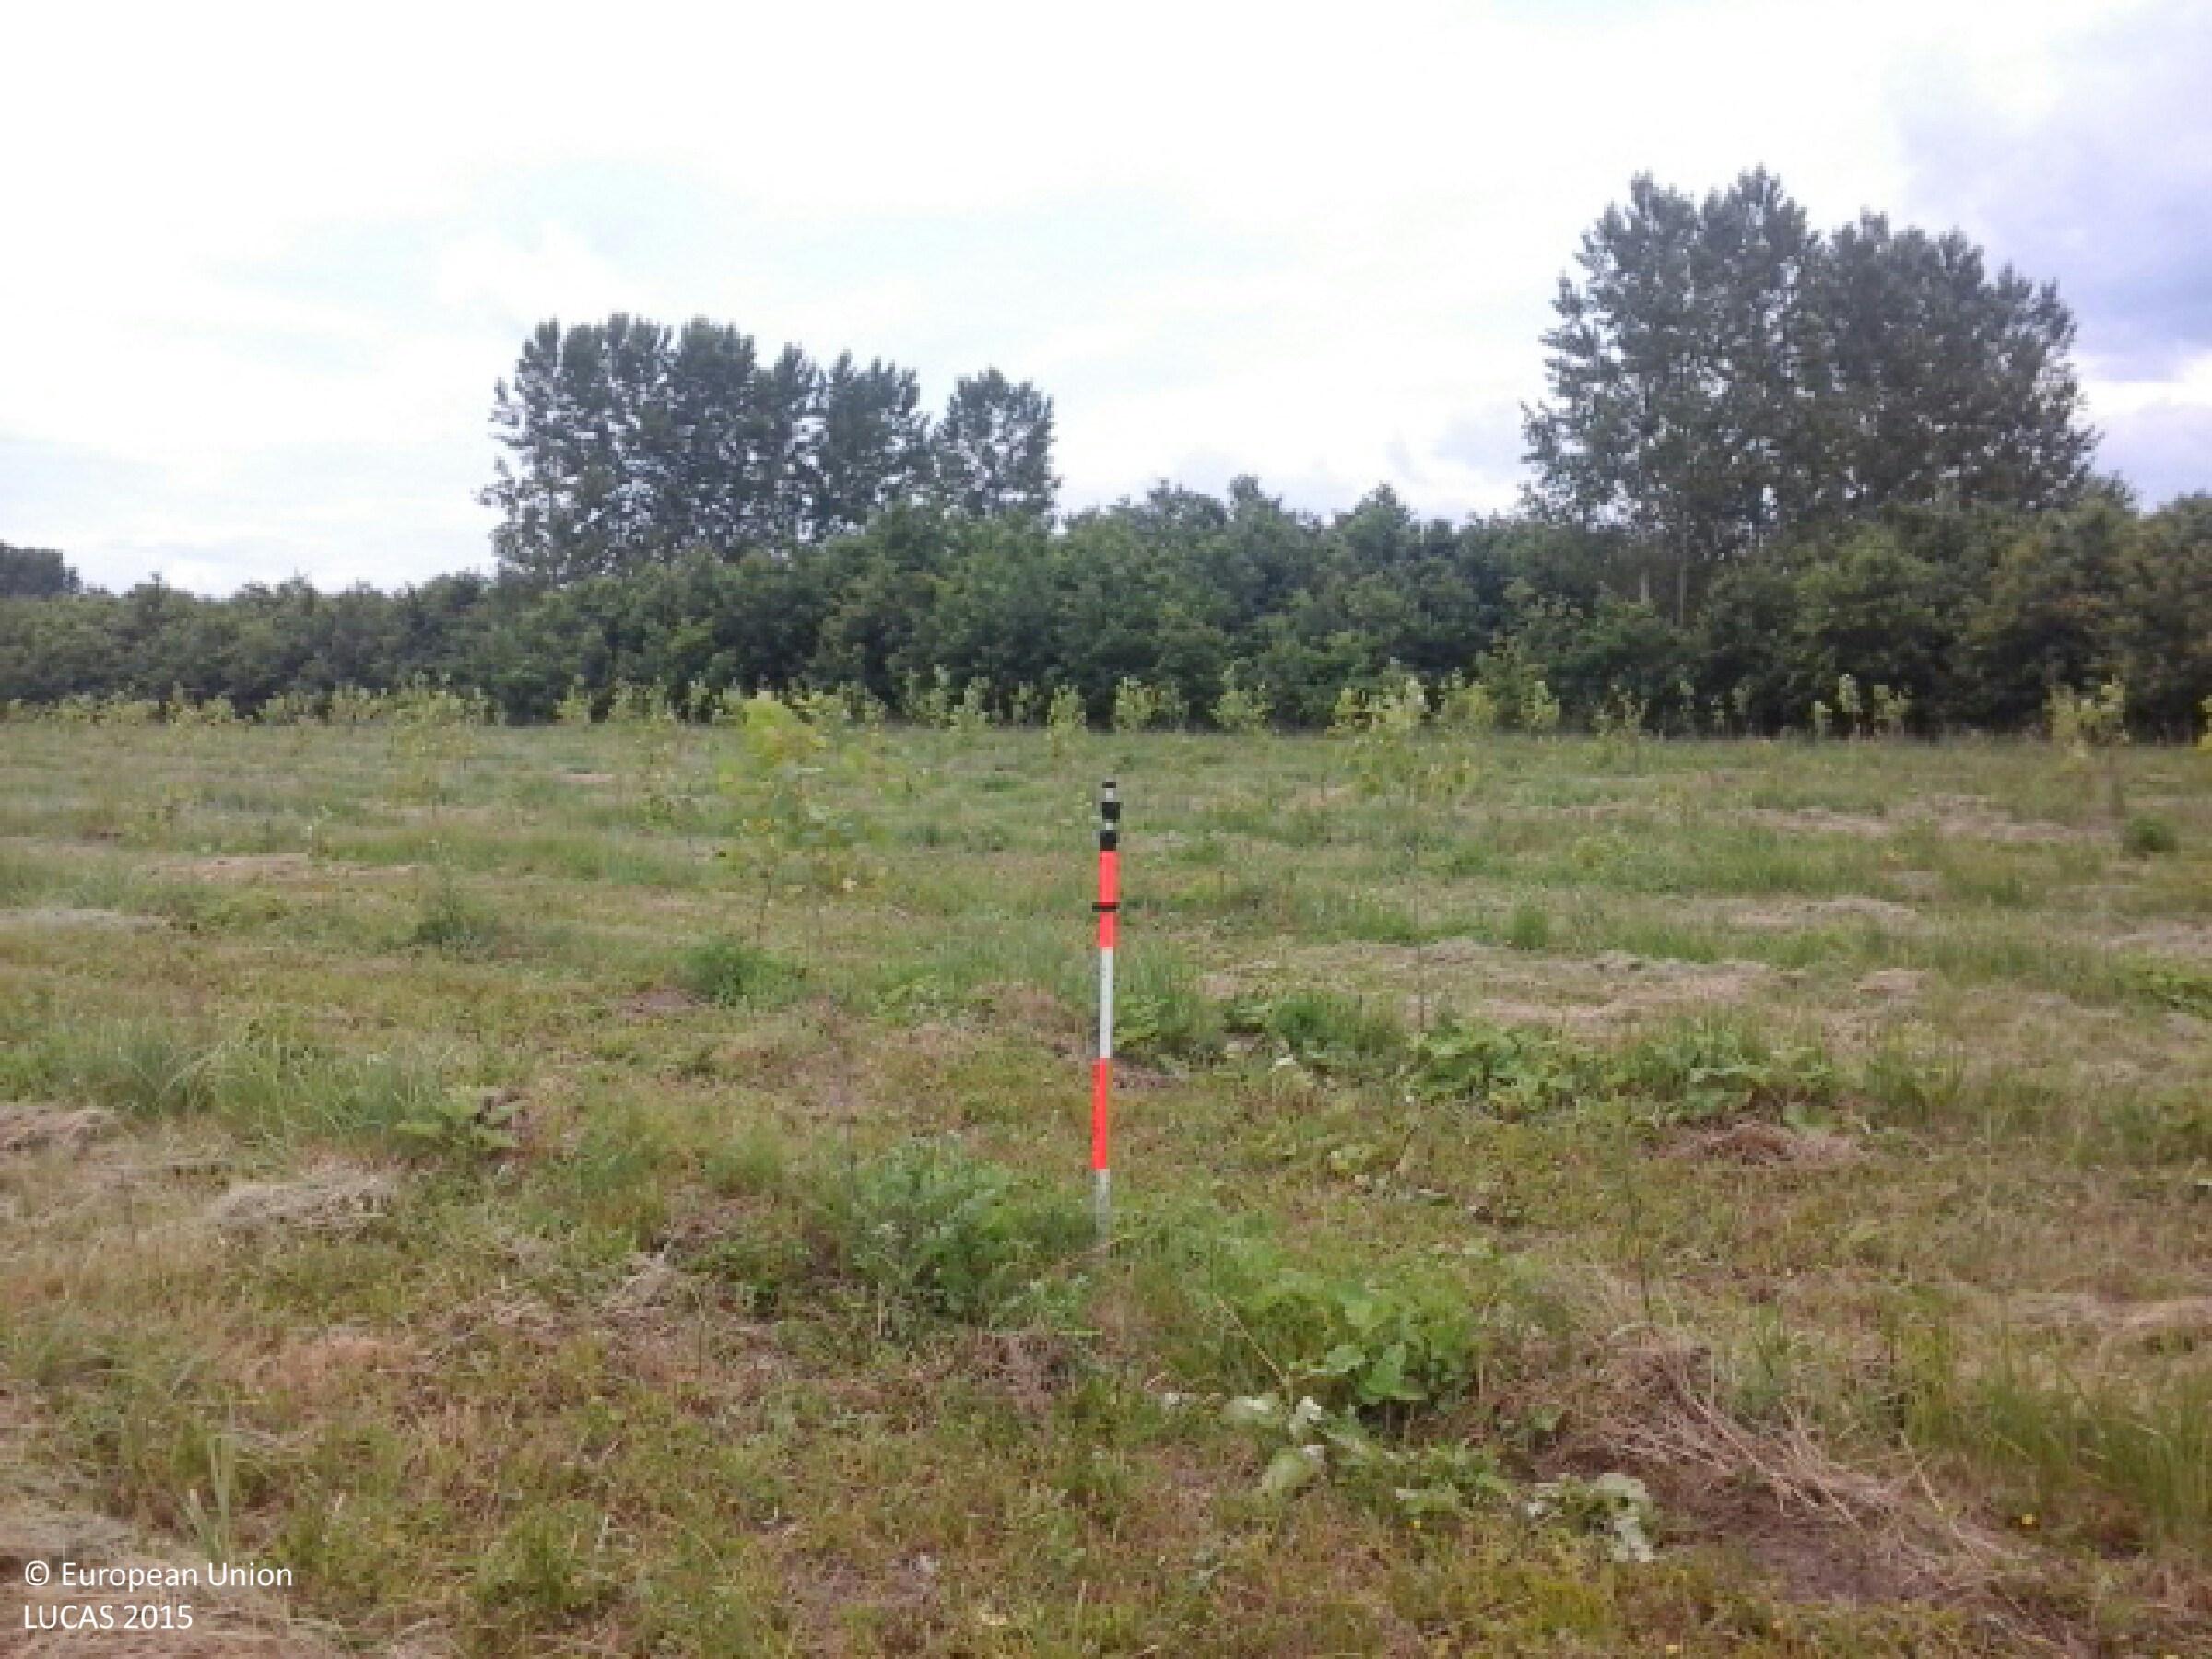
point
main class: Grassland
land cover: Grassland with sparse tree/shrub cover
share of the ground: > 75 %
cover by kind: herbaceous plants 95 %, broadleaved forest trees 5 %
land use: Agriculture (excluding fallow land and kitchen gardens)
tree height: < 5 m
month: June
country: HU
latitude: 48.1732
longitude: 21.7622
